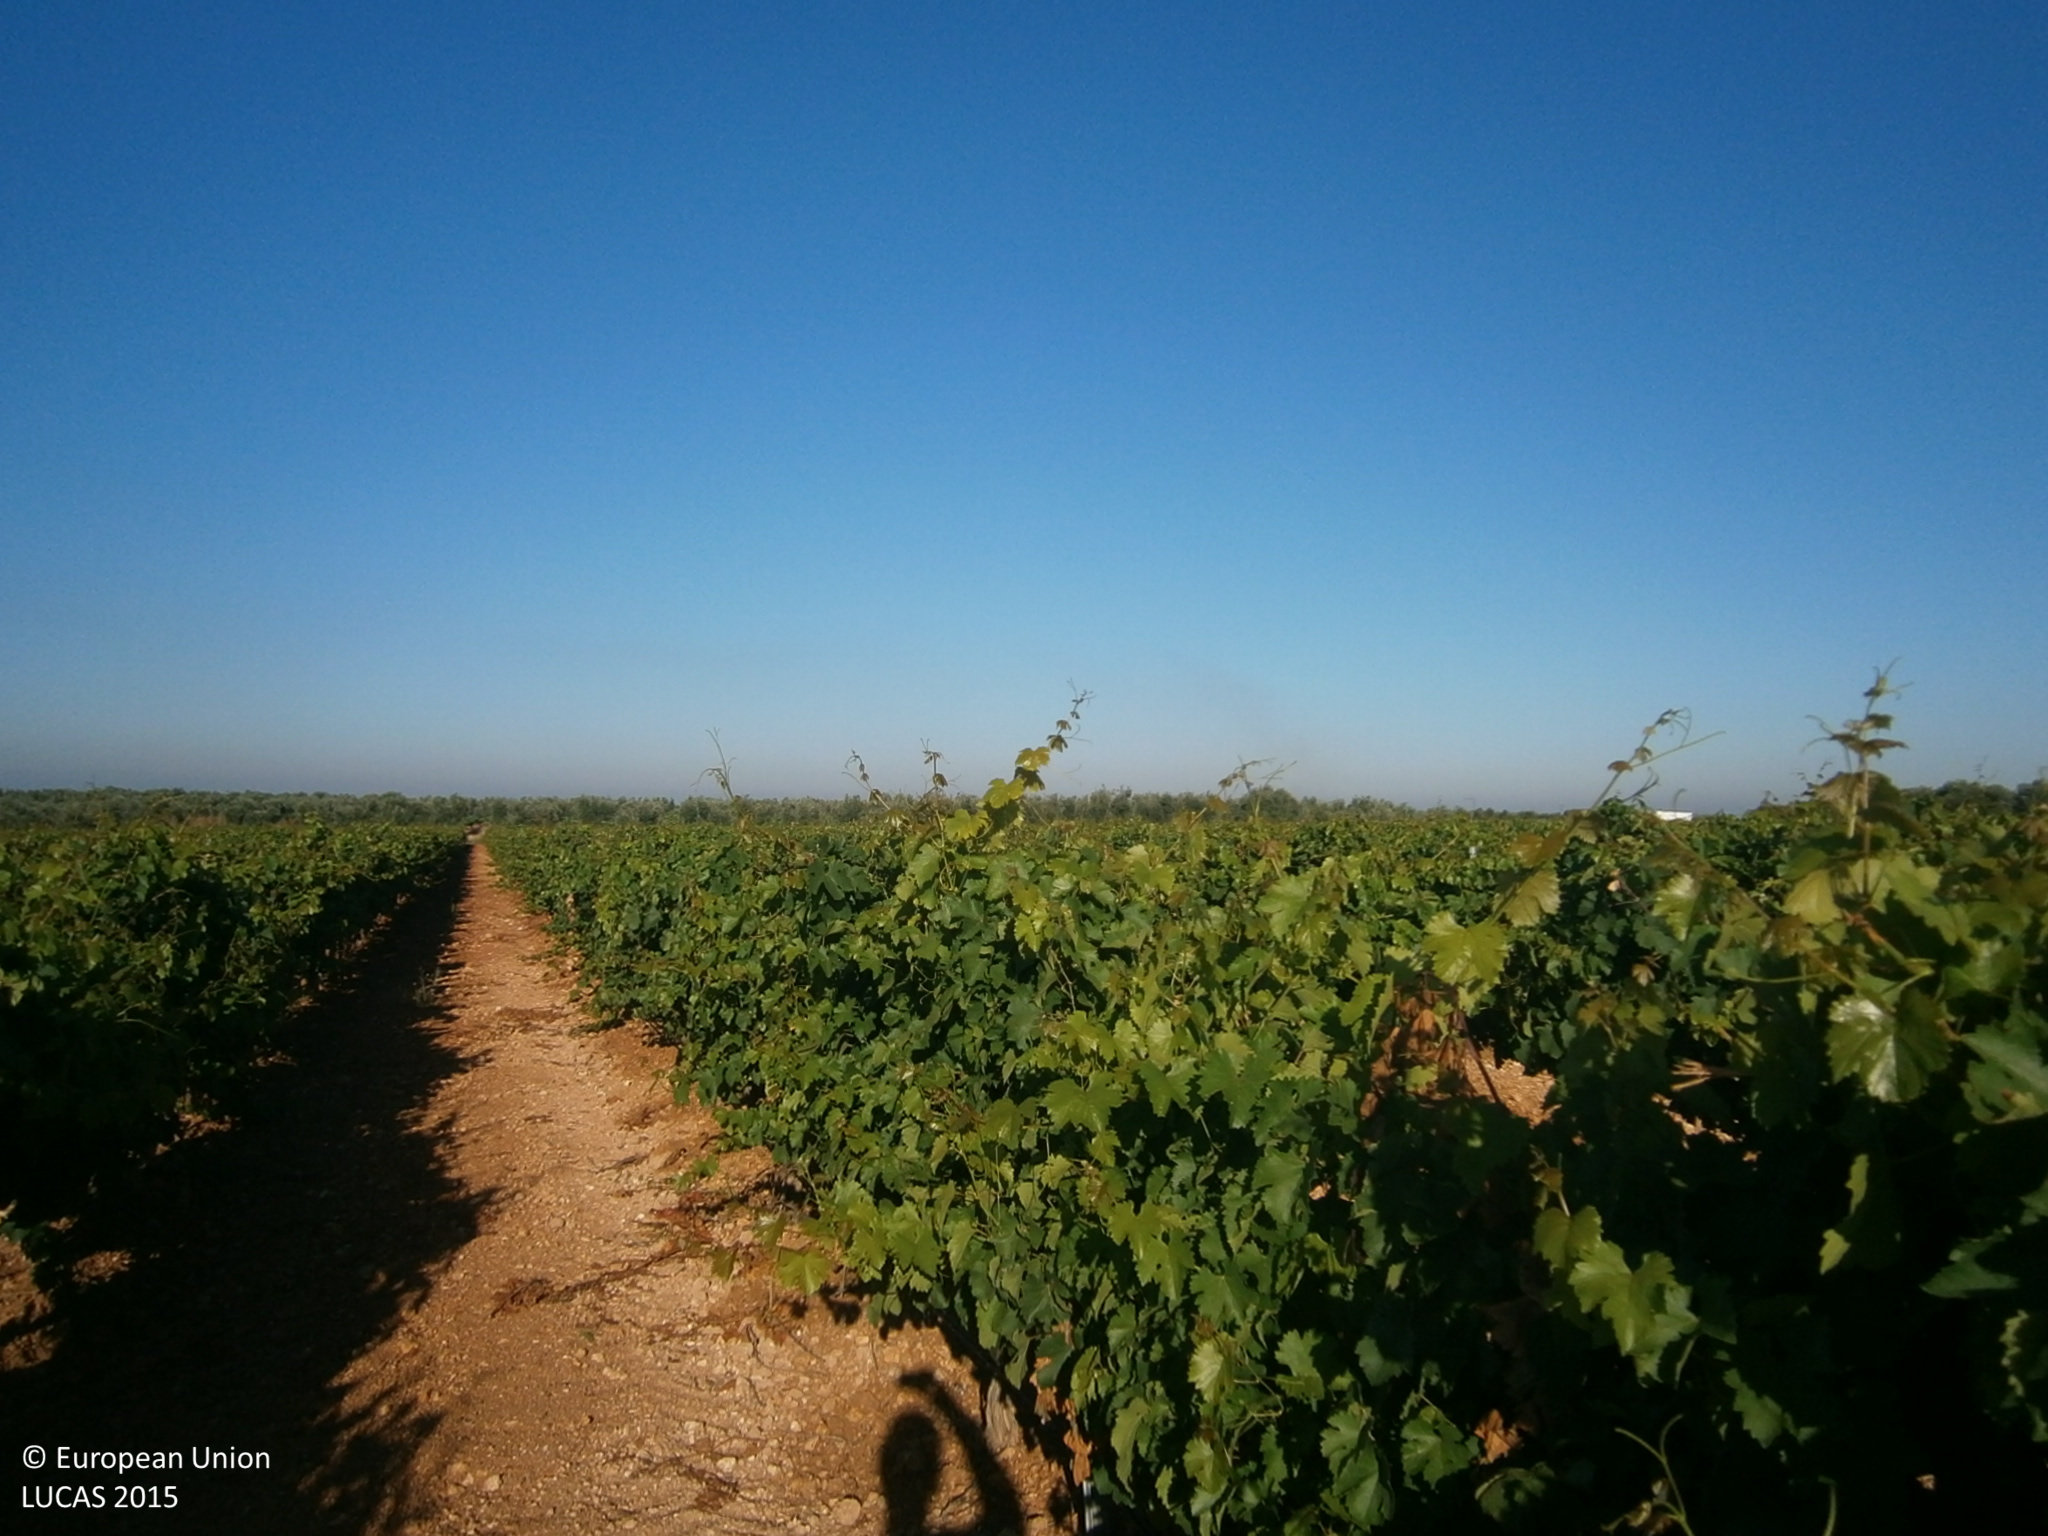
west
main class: Cropland
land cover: Vineyards
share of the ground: 25 - 50 %
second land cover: Other bare soil
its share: > 75 %
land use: Agriculture (excluding fallow land and kitchen gardens)
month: June
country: ES
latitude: 38.7782
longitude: -6.4370
